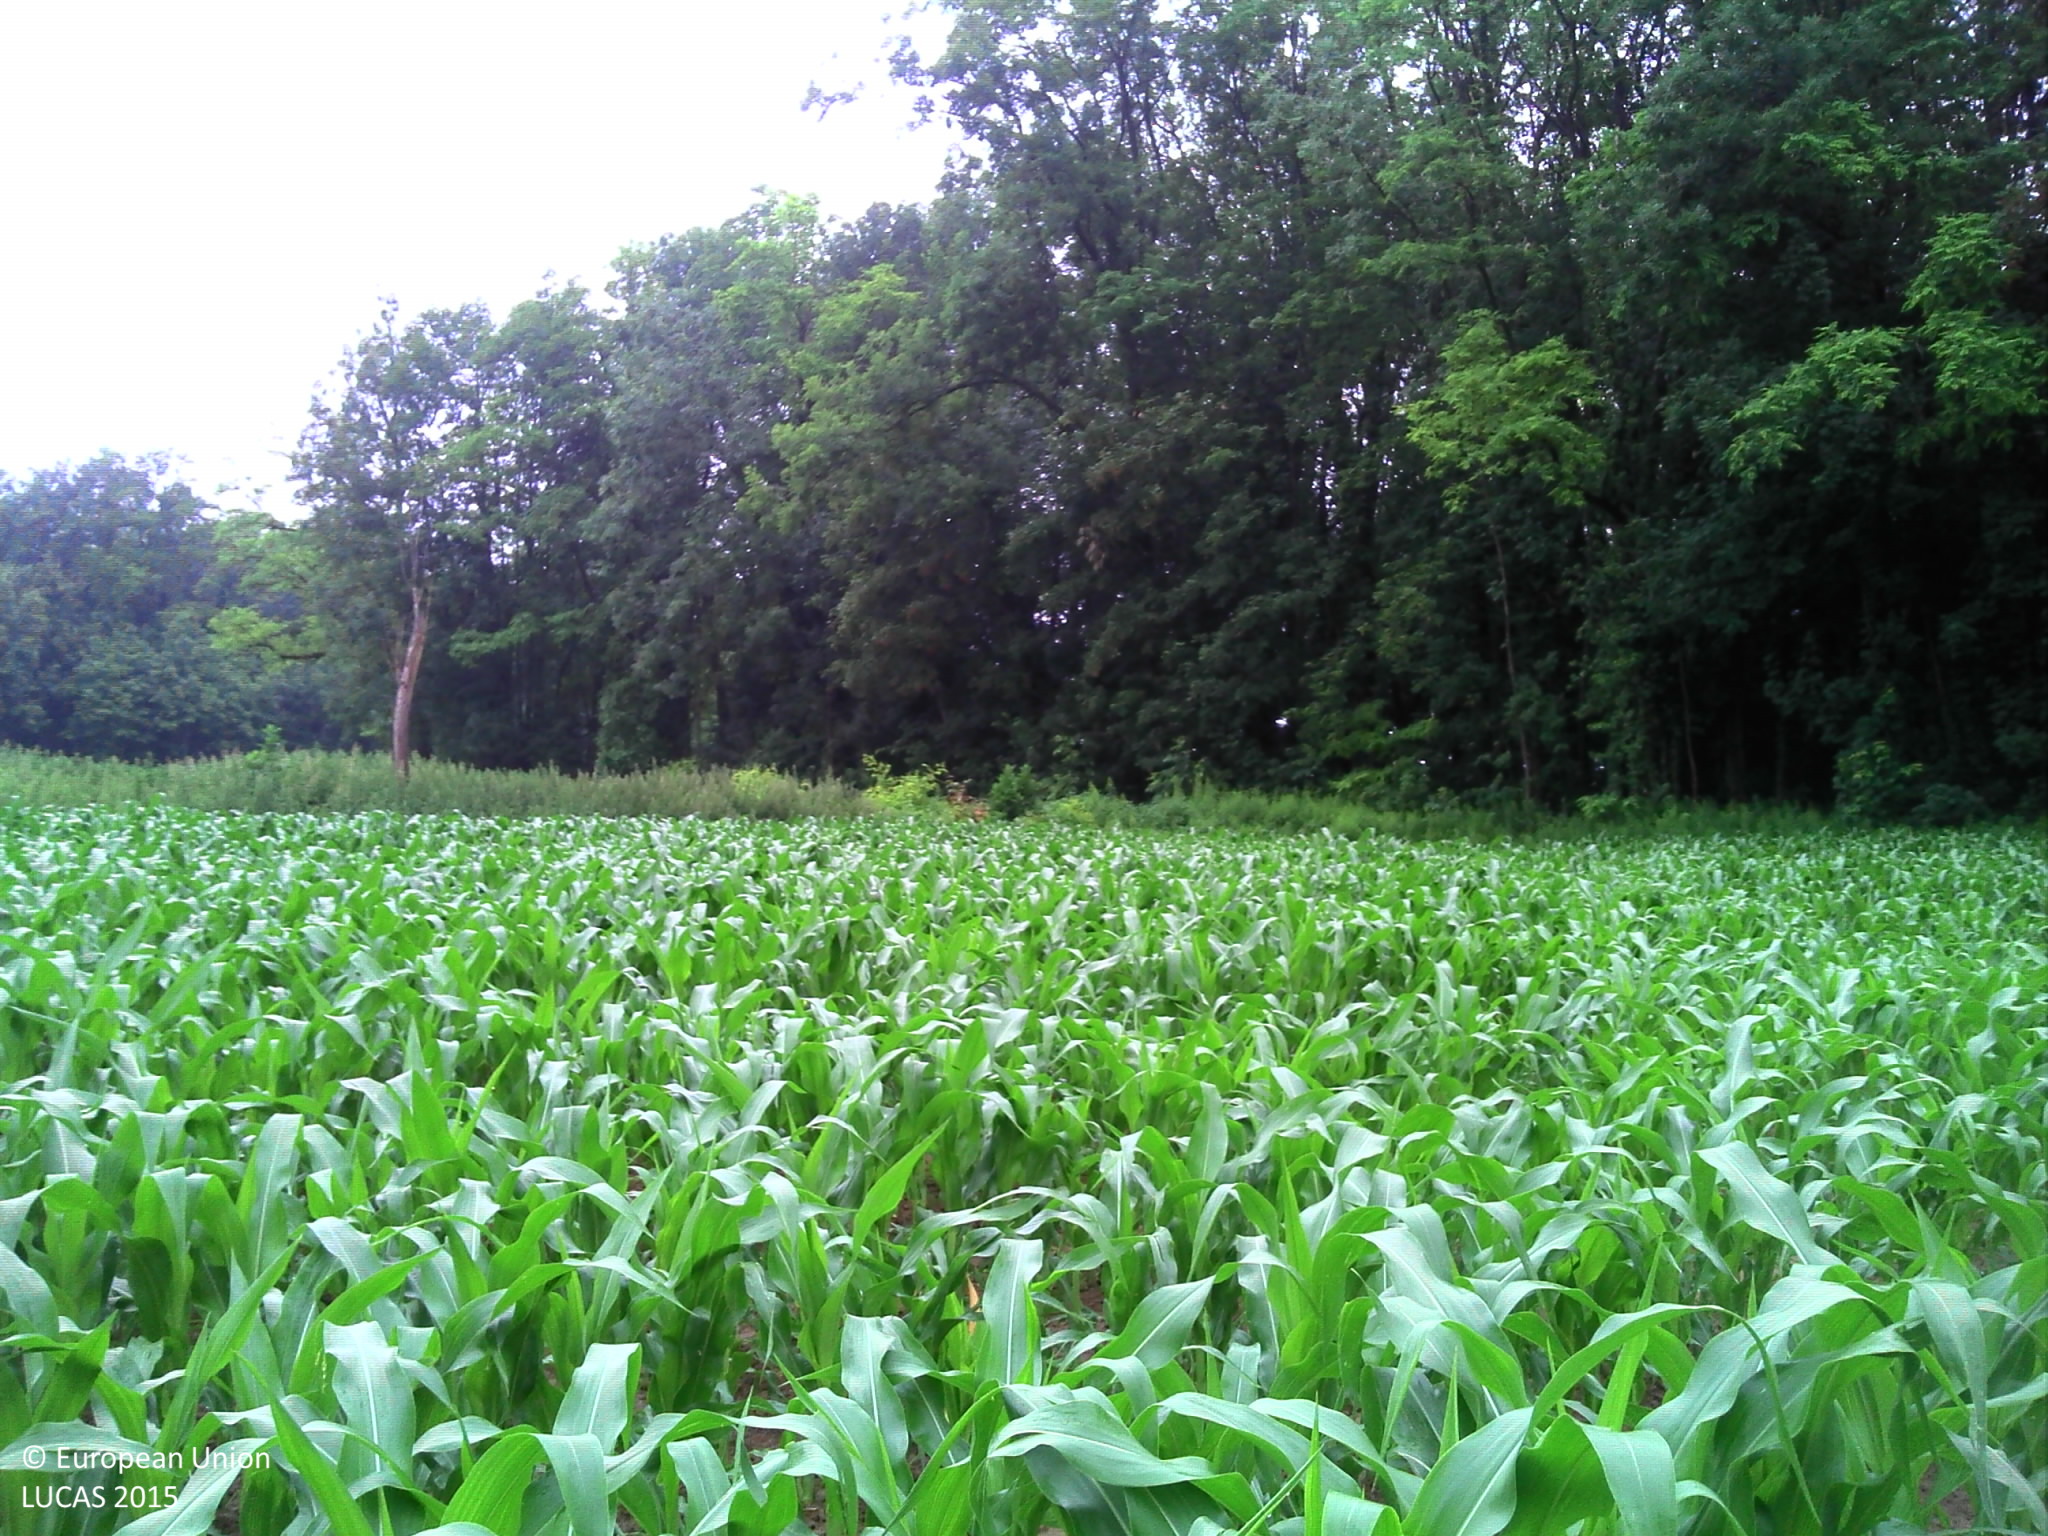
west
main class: Cropland
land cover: Maize
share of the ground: > 75 %
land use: Agriculture (excluding fallow land and kitchen gardens)
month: June
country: FR
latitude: 47.7062
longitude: 7.3760
